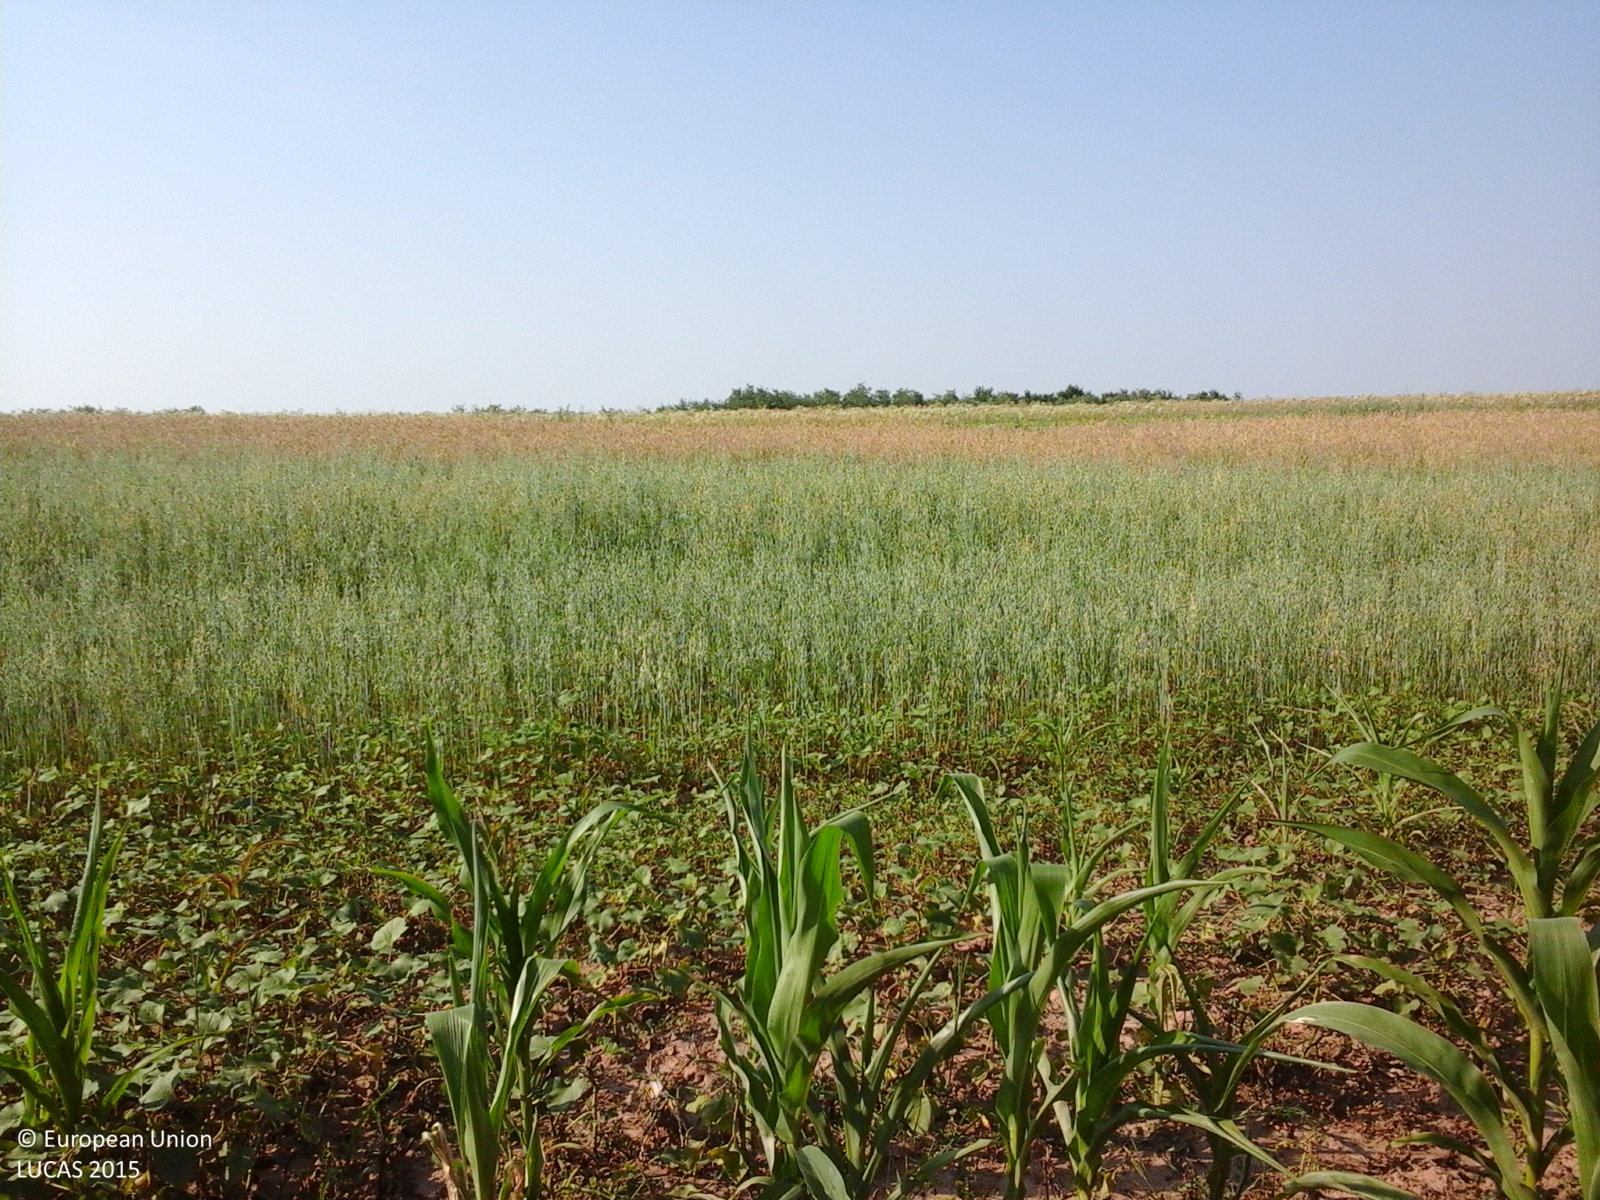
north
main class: Cropland
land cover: Maize
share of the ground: 50 - 75 %
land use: Agriculture (excluding fallow land and kitchen gardens)
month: July
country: RO
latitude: 44.6741
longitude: 24.6710
